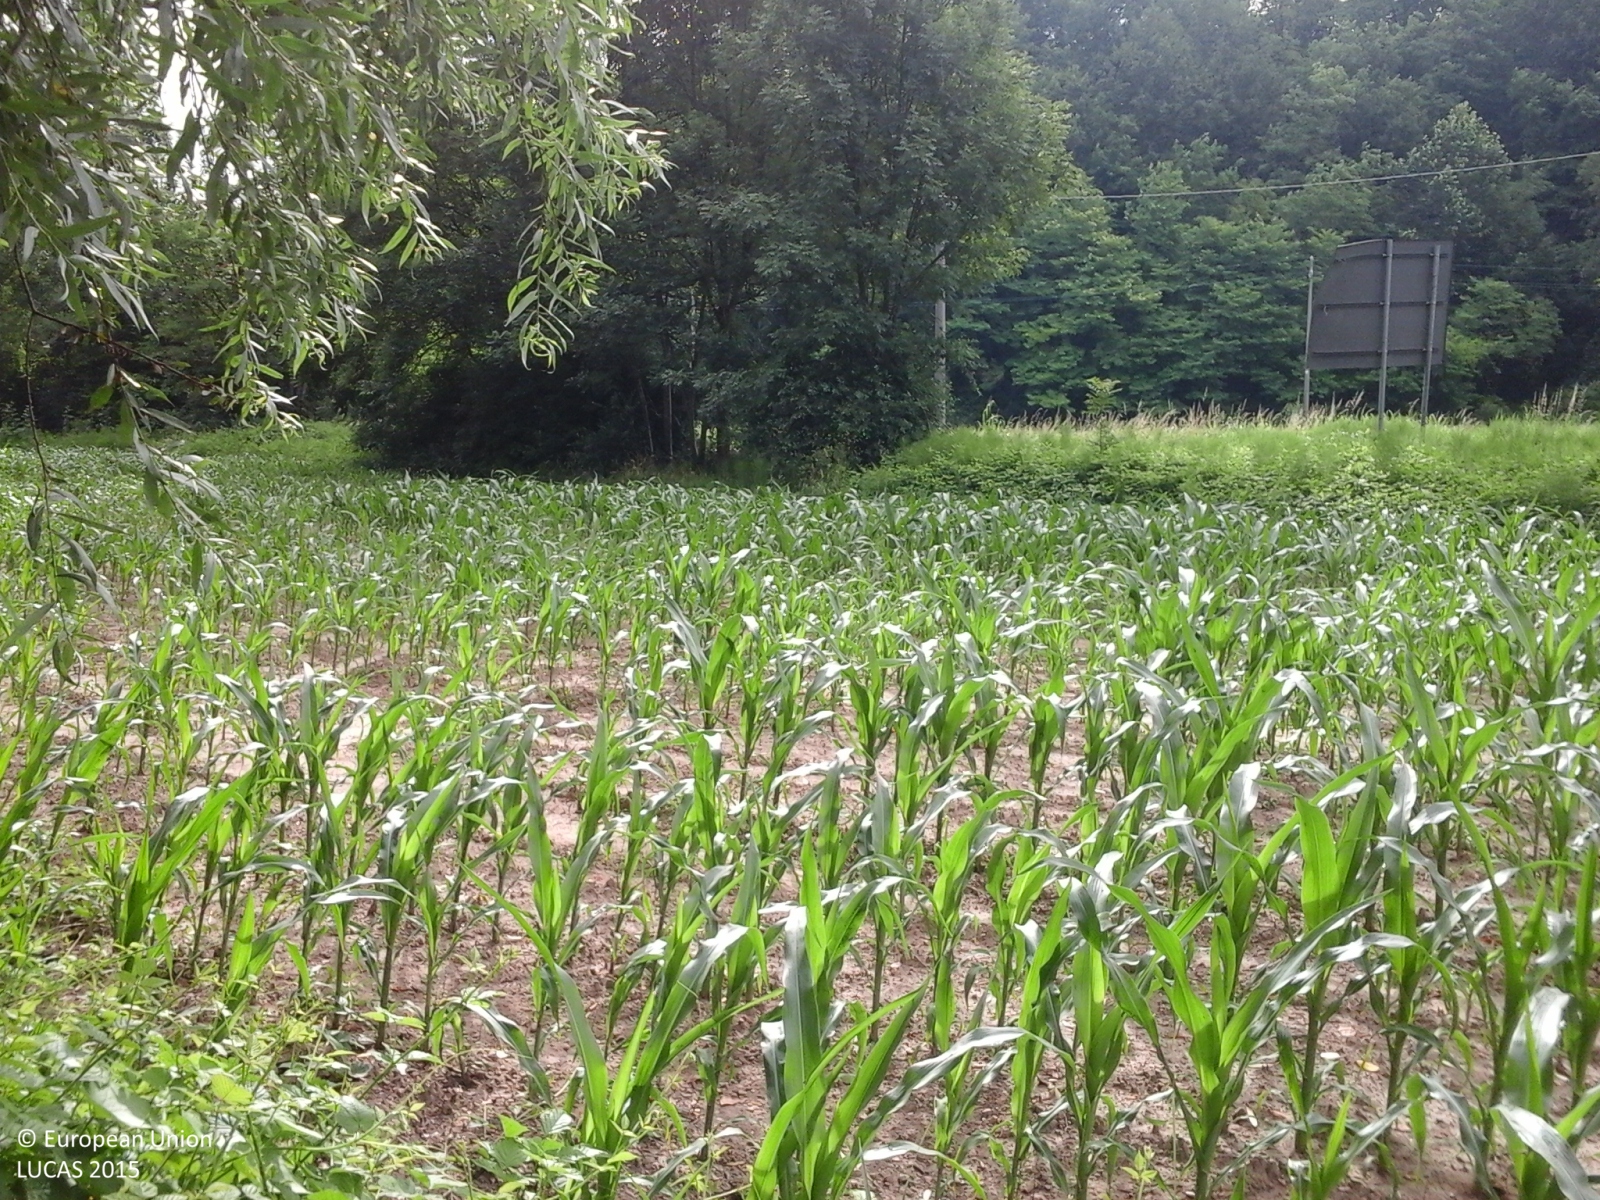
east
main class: Woodland
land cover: Broadleaved woodland
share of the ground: > 75 %
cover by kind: broadleaved forest trees 75 %, shrubs 25 %
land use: Forestry
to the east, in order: Broadleaved woodland; Maize; Abandoned hedges; Paved roads, cycling and walking lanes; Grassland without tree/shrub cover; Electric lines; Grassland without tree/shrub cover; Electric lines; Broadleaved woodland; Rivers and streams; Broadleaved woodland; Paved roads, cycling and walking lanes; Broadleaved woodland; Rivers and streams; Broadleaved woodland; Grassland without tree/shrub cover
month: June
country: IT
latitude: 45.9298
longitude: 8.7767
